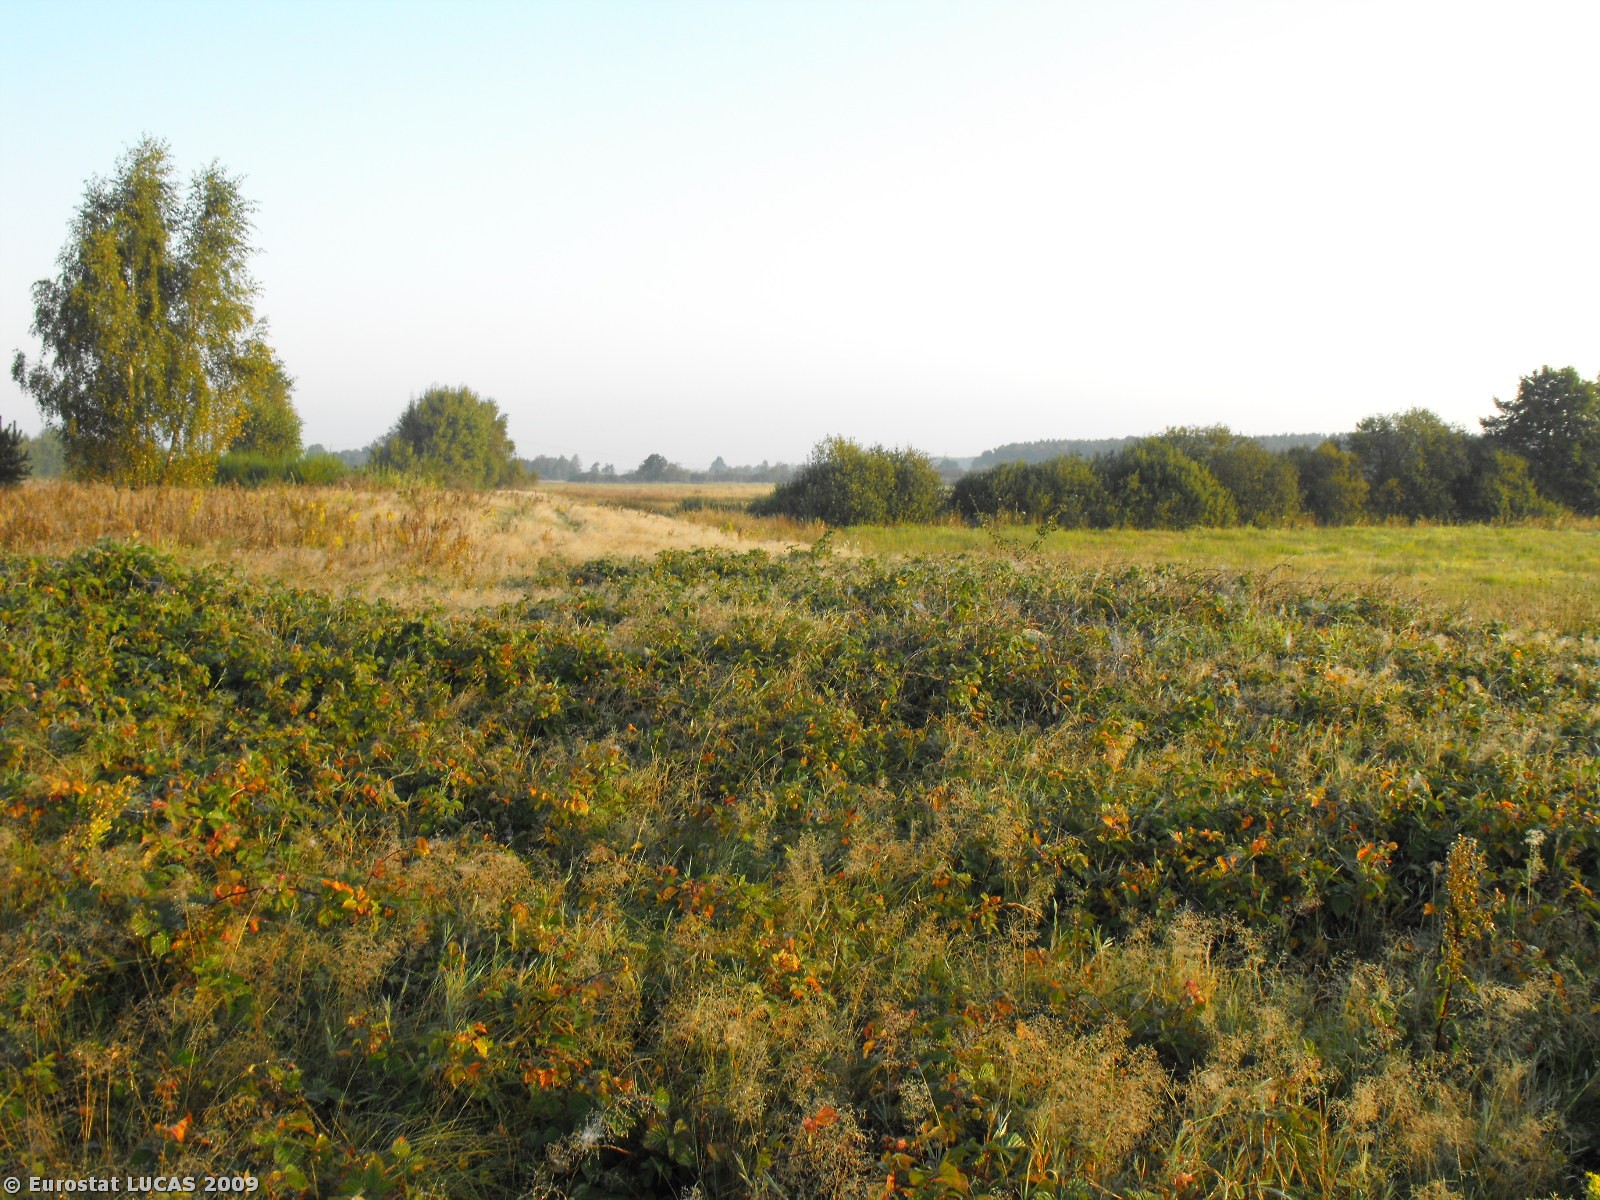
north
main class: Grassland
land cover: Grassland with sparse tree/shrub cover
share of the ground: > 75 %
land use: Nature reserves
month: September
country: PL
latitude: 54.4227
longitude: 16.7420
